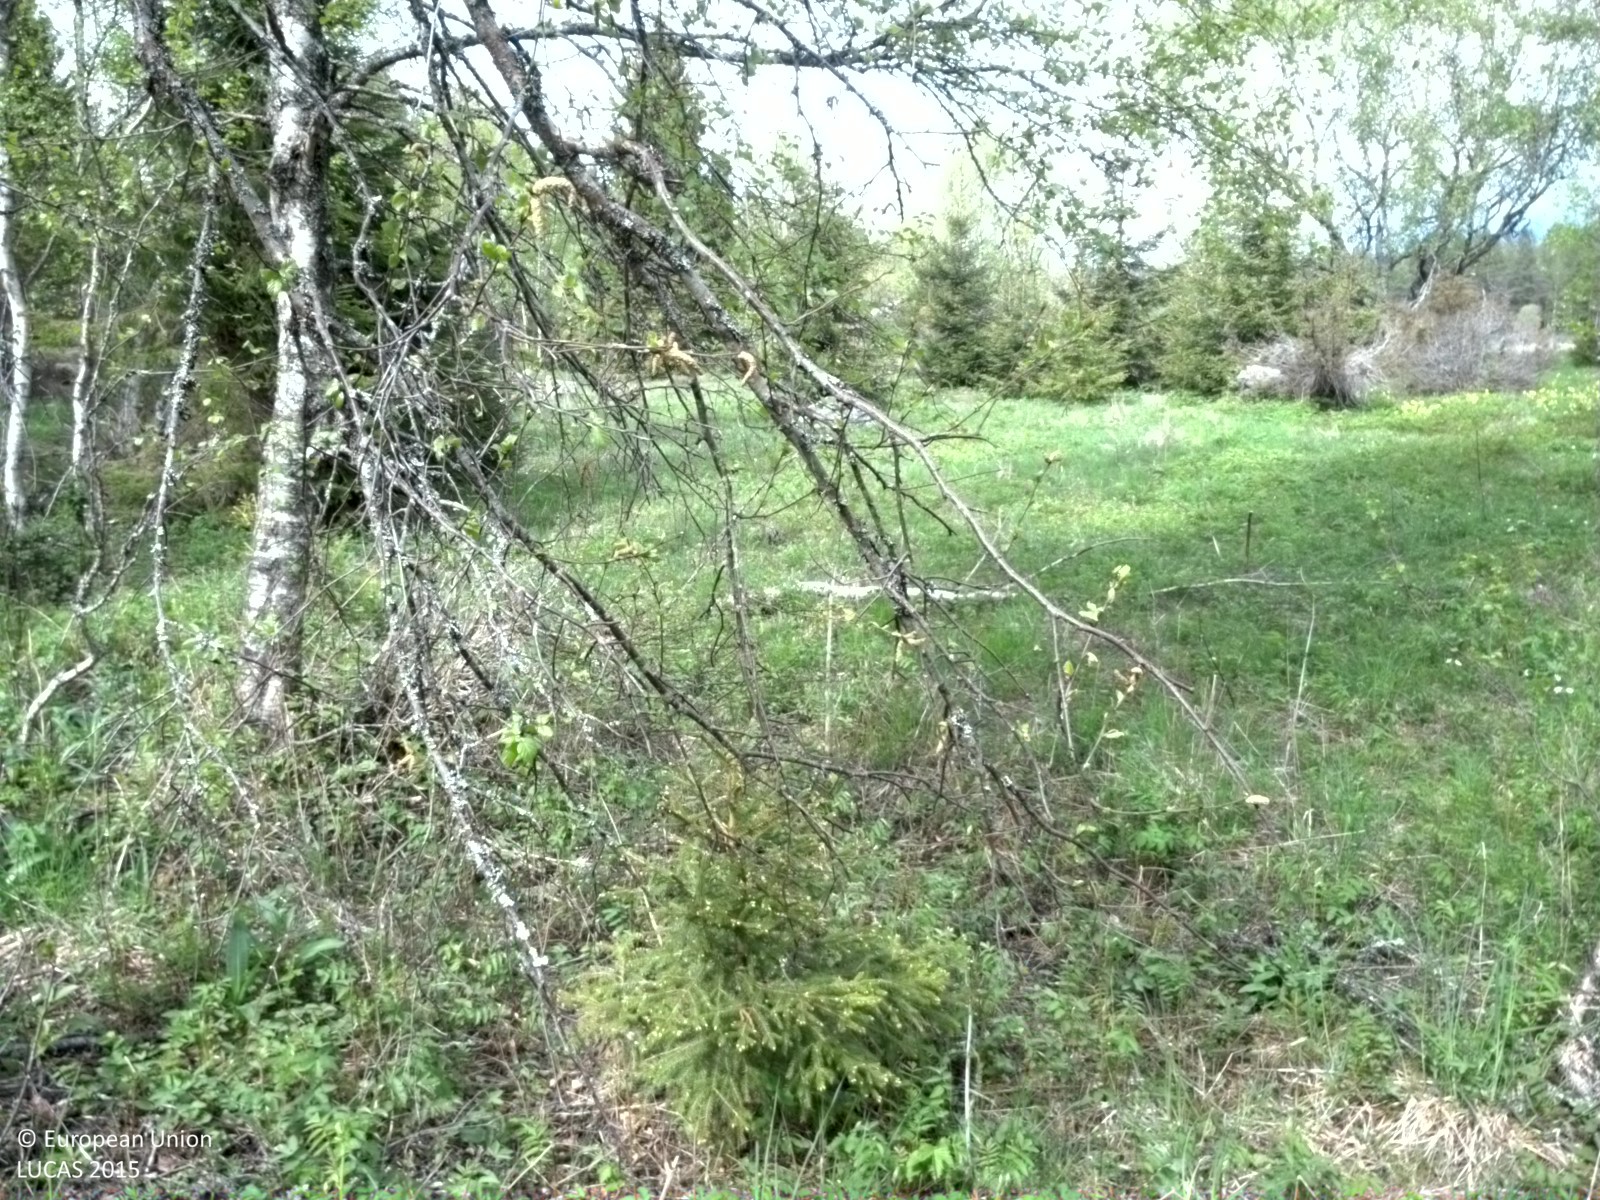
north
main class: Woodland
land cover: Broadleaved woodland
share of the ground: 25 - 50 %
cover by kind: herbaceous plants 50 %, broadleaved forest trees 35 %, shrubs 10 %, coniferous forest trees 5 %
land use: Forestry
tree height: > 5 m
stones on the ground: 10 - 25 %
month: May
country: SE
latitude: 60.2770
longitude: 18.0403
